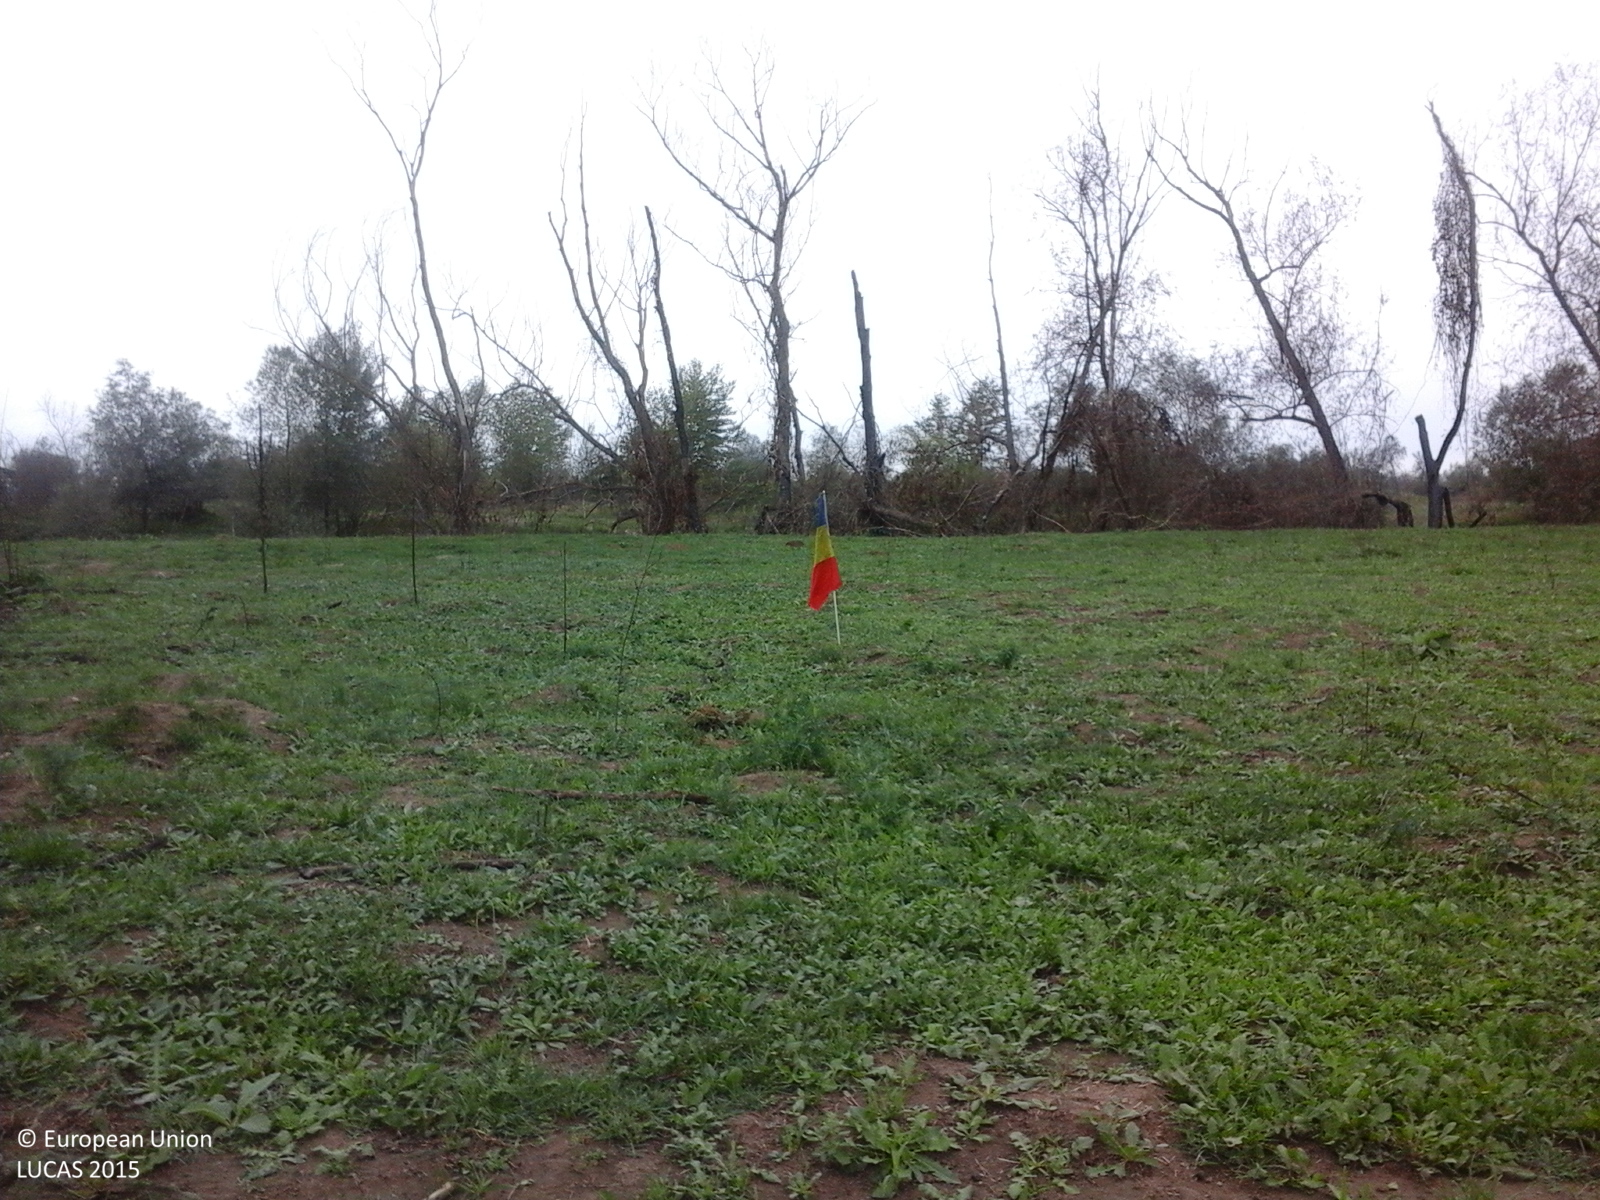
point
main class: Grassland
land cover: Grassland without tree/shrub cover
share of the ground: > 75 %
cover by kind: herbaceous plants 100 %
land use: Agriculture (excluding fallow land and kitchen gardens)
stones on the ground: < 10 %
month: September
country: RO
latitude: 45.6326
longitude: 22.0338
